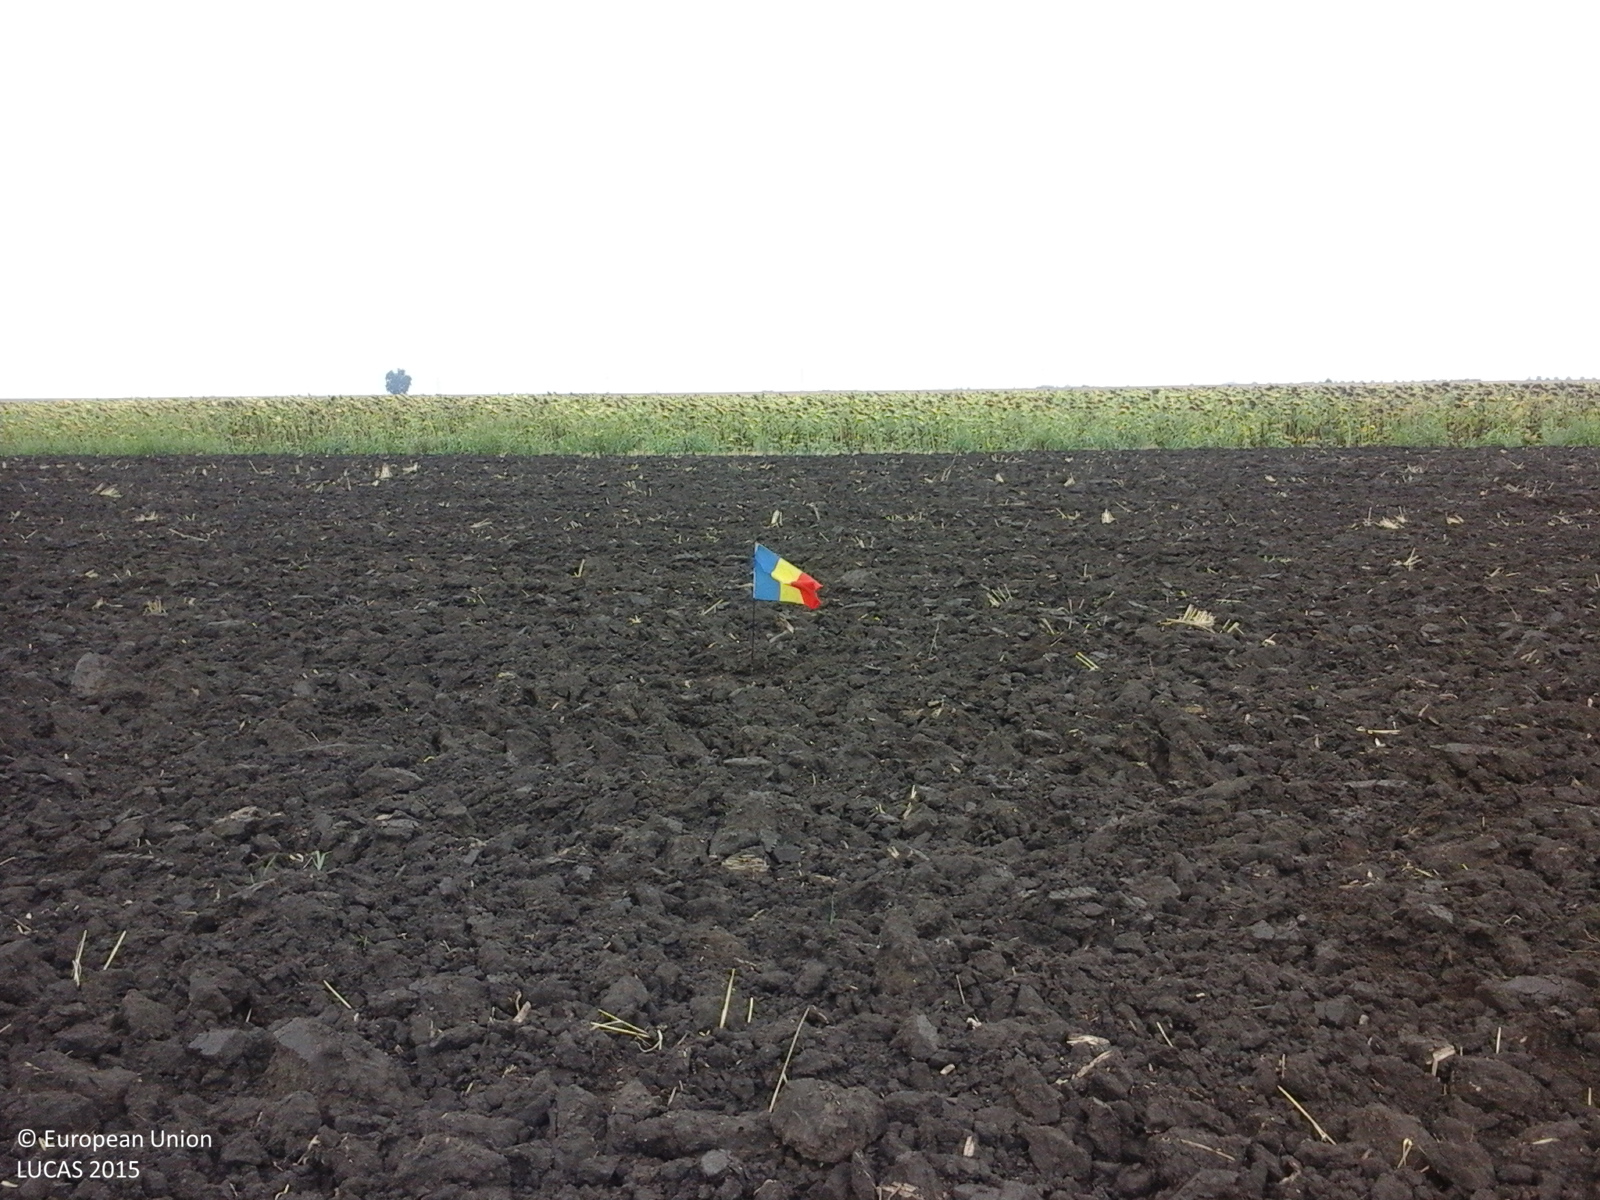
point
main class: Cropland
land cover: Common wheat
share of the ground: < 10 %
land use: Agriculture (excluding fallow land and kitchen gardens)
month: August
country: RO
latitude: 46.0298
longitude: 20.7107
